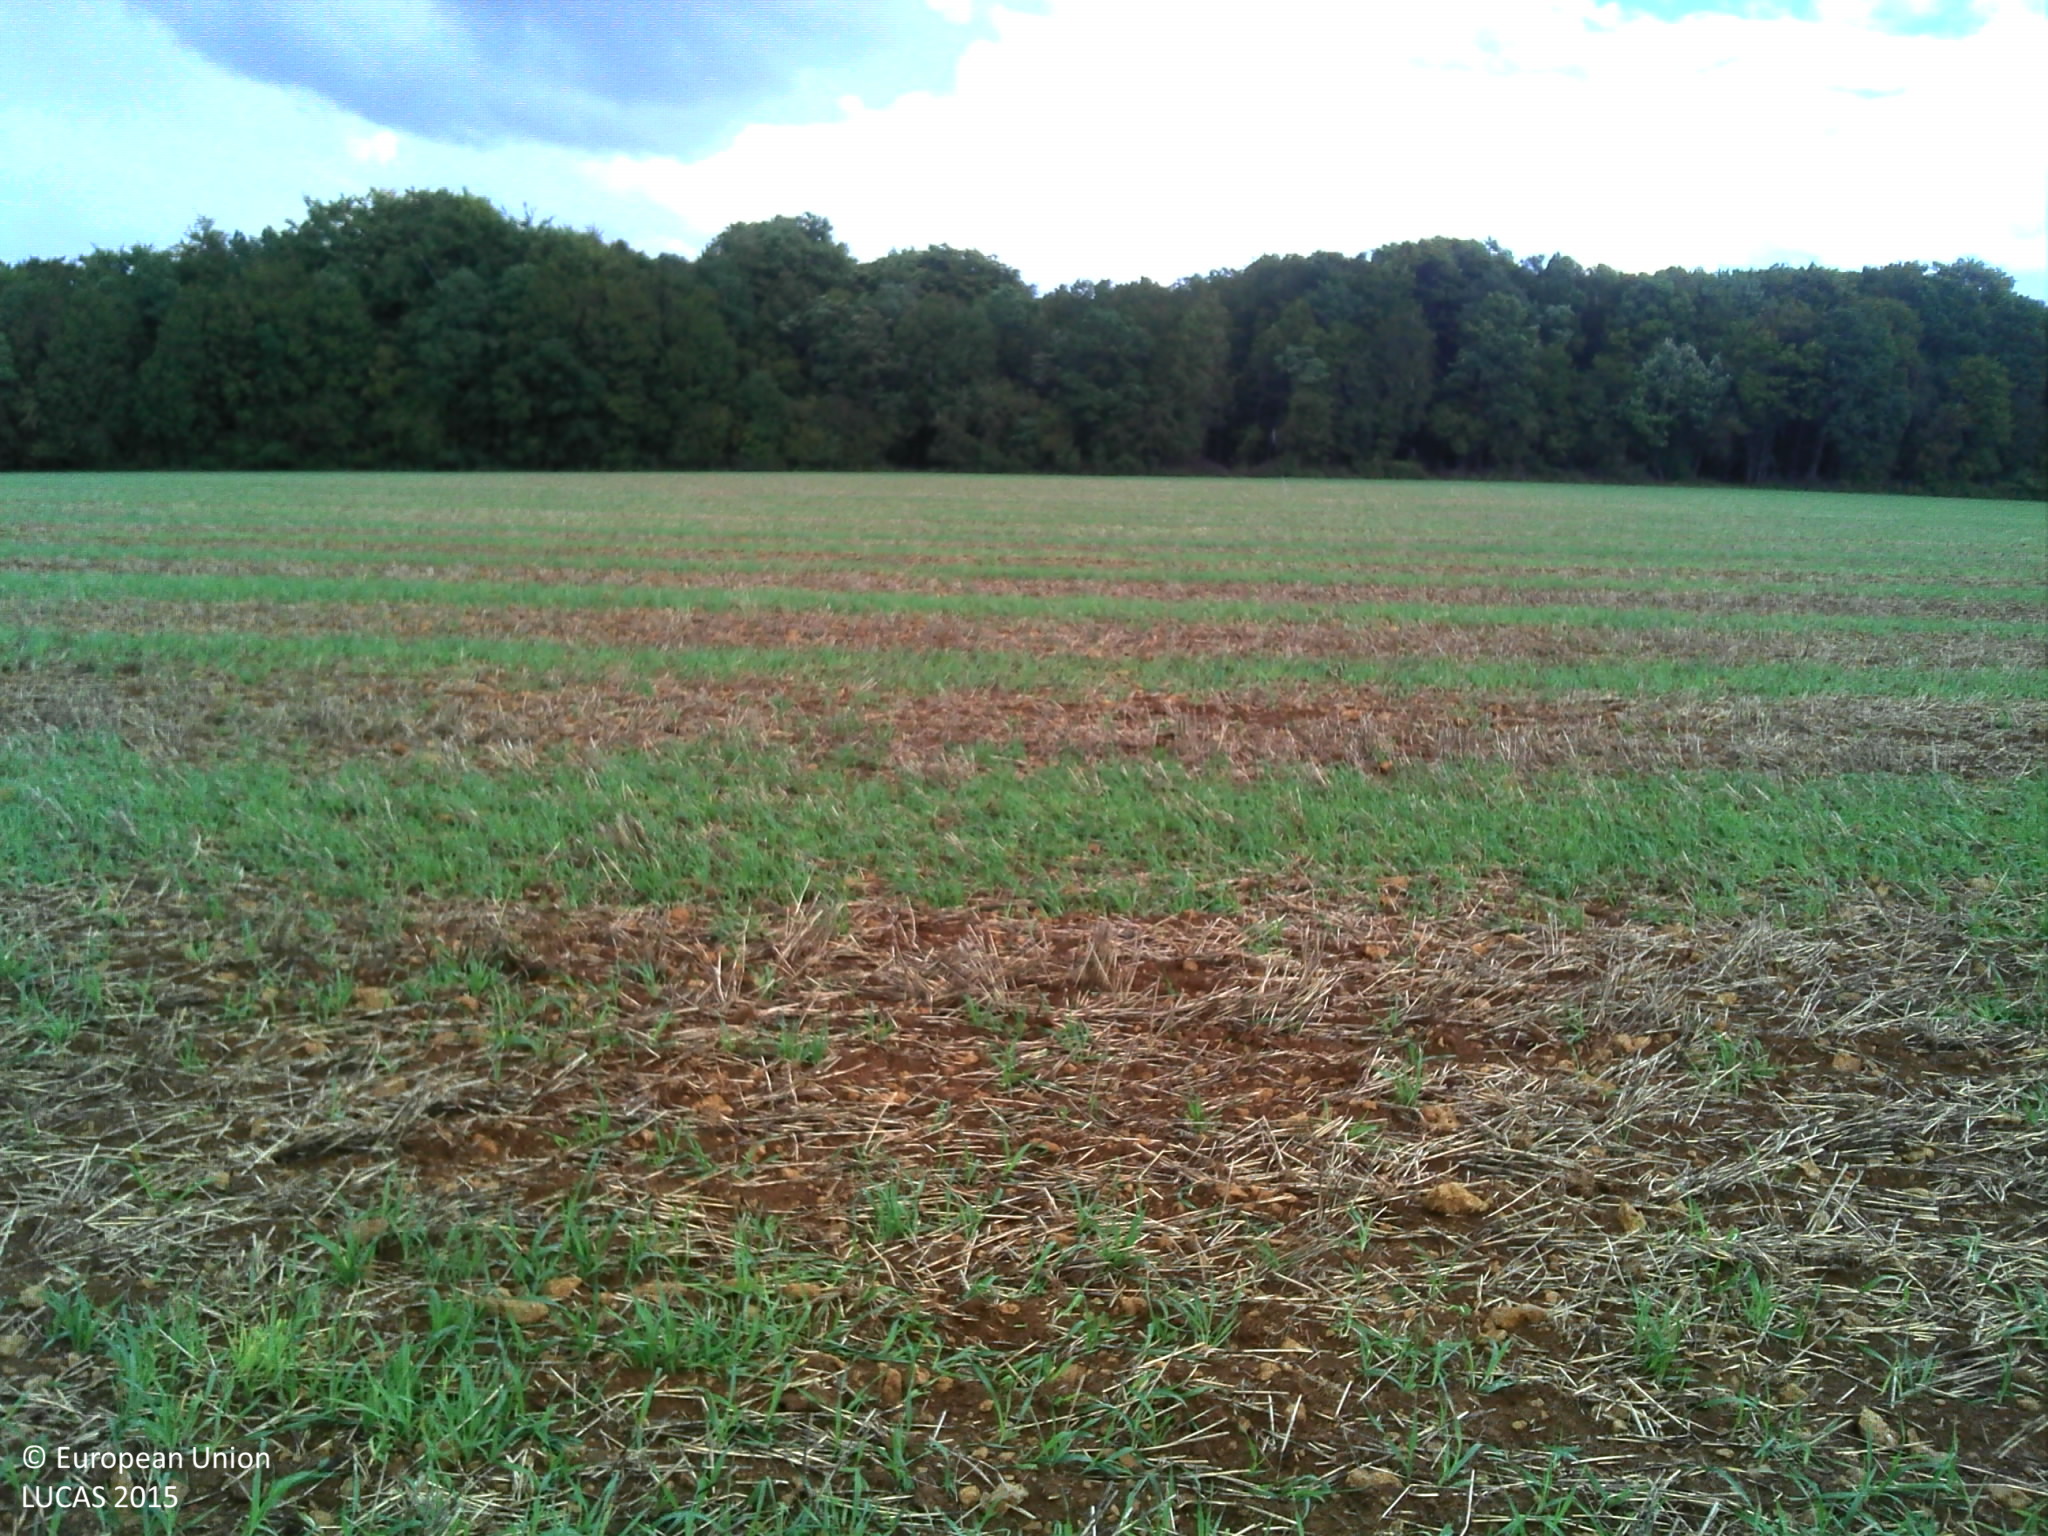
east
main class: Cropland
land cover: Common wheat
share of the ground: < 10 %
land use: Agriculture (excluding fallow land and kitchen gardens)
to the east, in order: Common wheat; Grass margins; Broadleaved woodland; Ditches and canals; Broadleaved woodland; Tracks; Broadleaved woodland
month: September
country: FR
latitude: 48.8867
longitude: 5.9218
